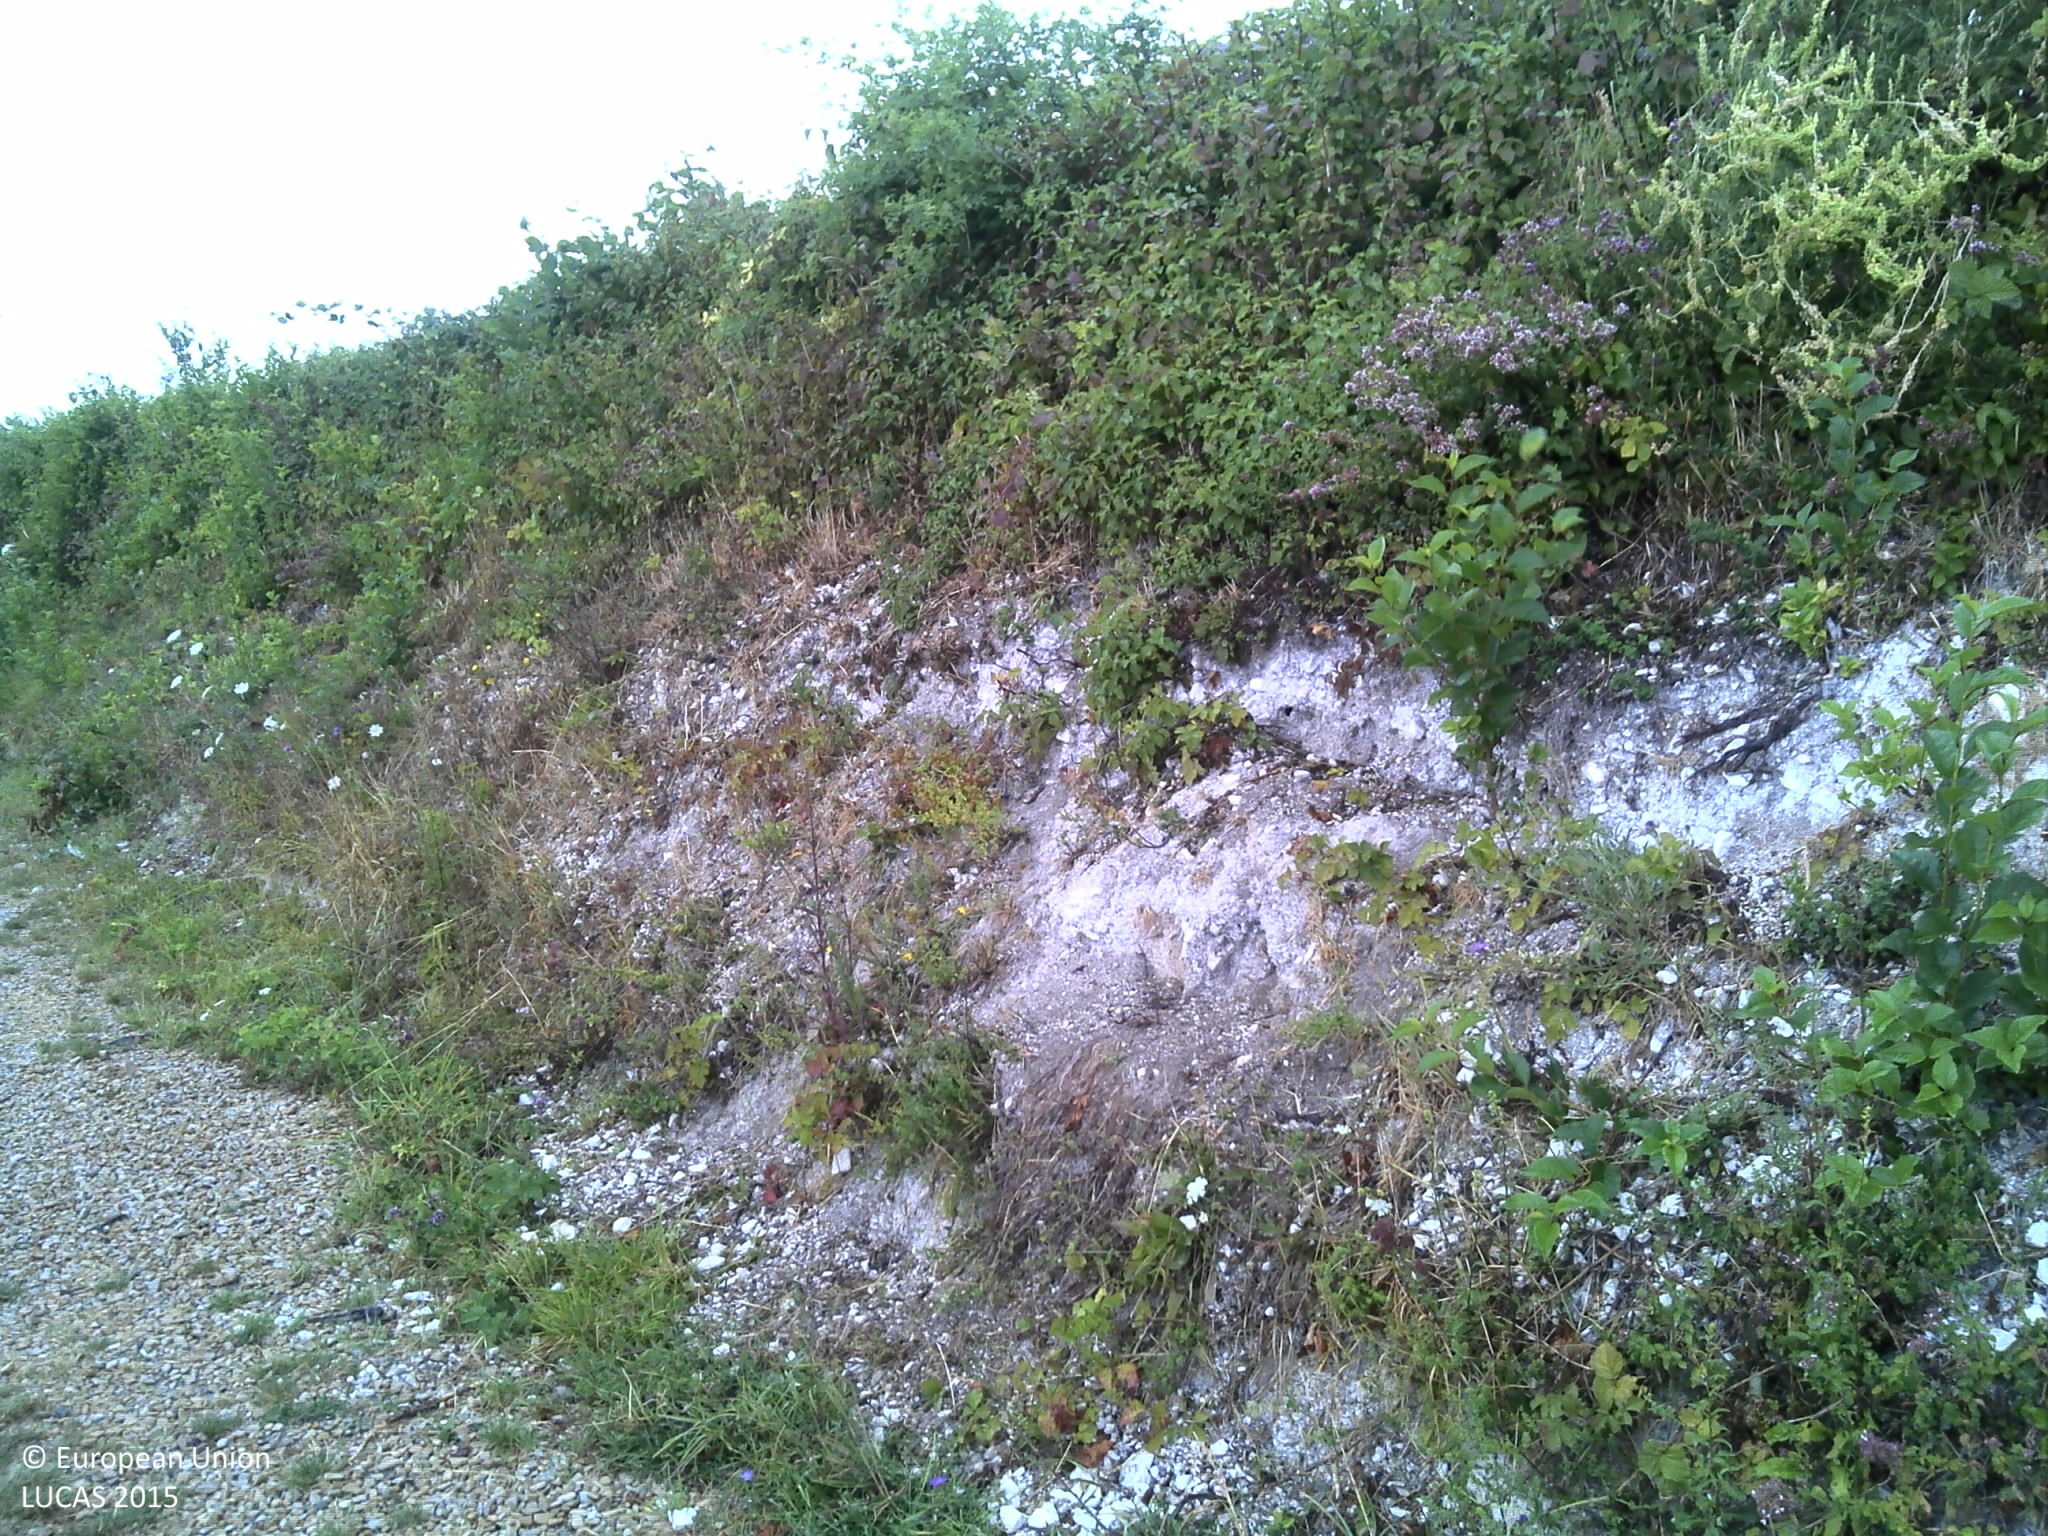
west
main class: Cropland
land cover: Vineyards
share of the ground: 25 - 50 %
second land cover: Other bare soil
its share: > 75 %
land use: Agriculture (excluding fallow land and kitchen gardens)
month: August
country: FR
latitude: 48.8160
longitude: 4.6724
